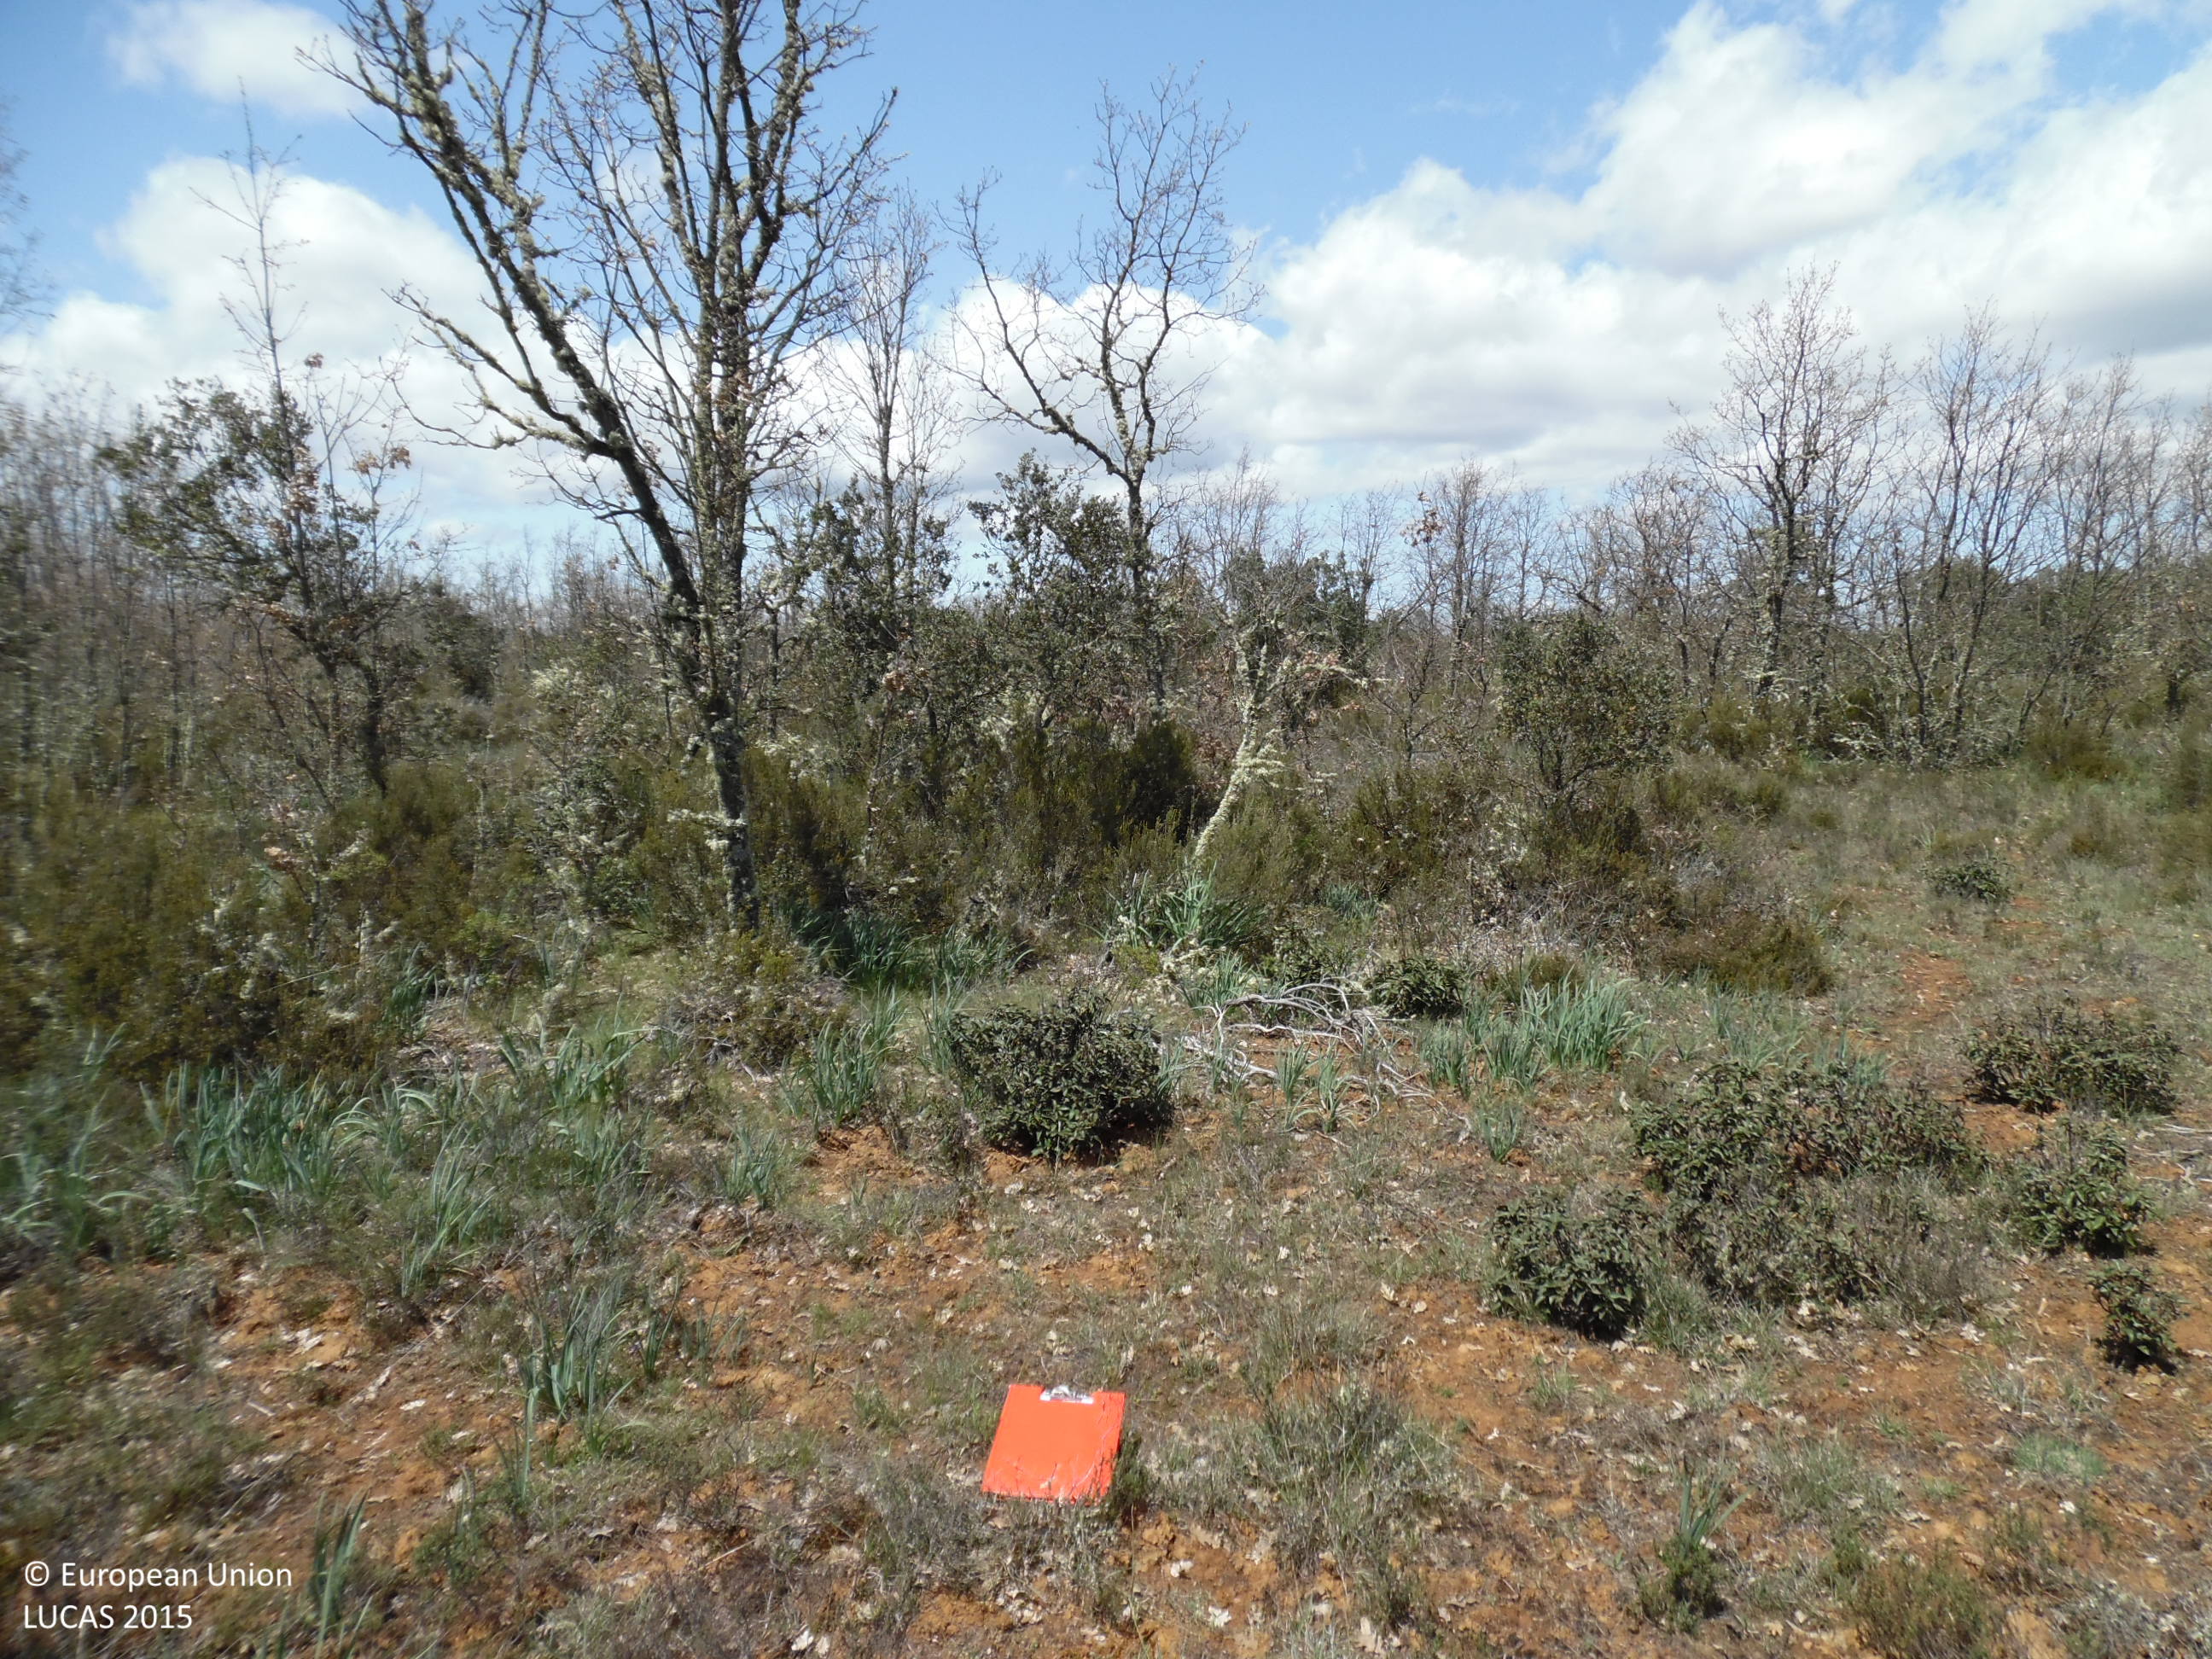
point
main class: Shrubland
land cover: Shrubland with sparse tree cover
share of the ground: > 75 %
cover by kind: shrubs 95 %, broadleaved forest trees 5 %
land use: Forestry
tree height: > 5 m
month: May
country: ES
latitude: 42.2870
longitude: -6.0263
